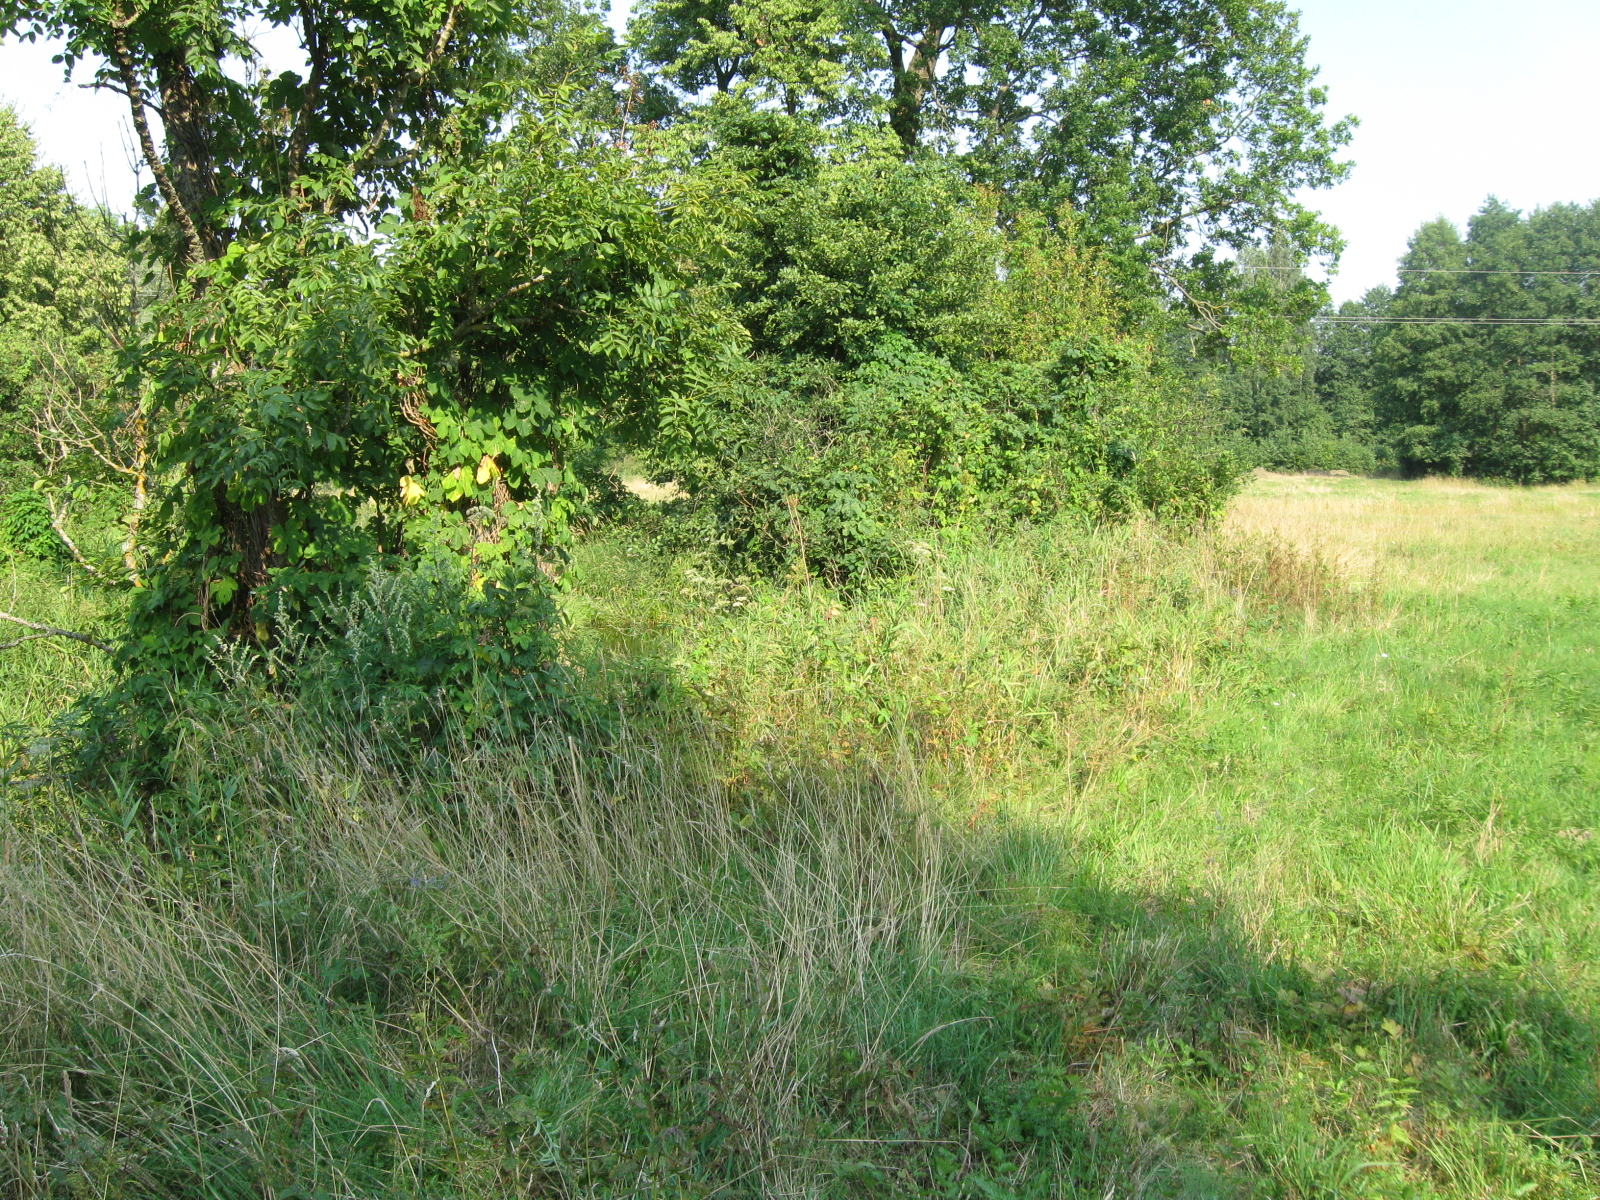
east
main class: Grassland
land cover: Grassland without tree/shrub cover
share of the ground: > 75 %
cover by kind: herbaceous plants 90 %, unconsolidated bare surface 10 %
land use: Agriculture (excluding fallow land and kitchen gardens)
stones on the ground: < 10 %
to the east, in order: Grassland without tree/shrub cover; Spontaneously vegetated surfaces; Broadleaved woodland; Grassland without tree/shrub cover; Electric lines; Grassland without tree/shrub cover; Broadleaved woodland
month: August
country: LT
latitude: 54.7369
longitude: 23.3580
